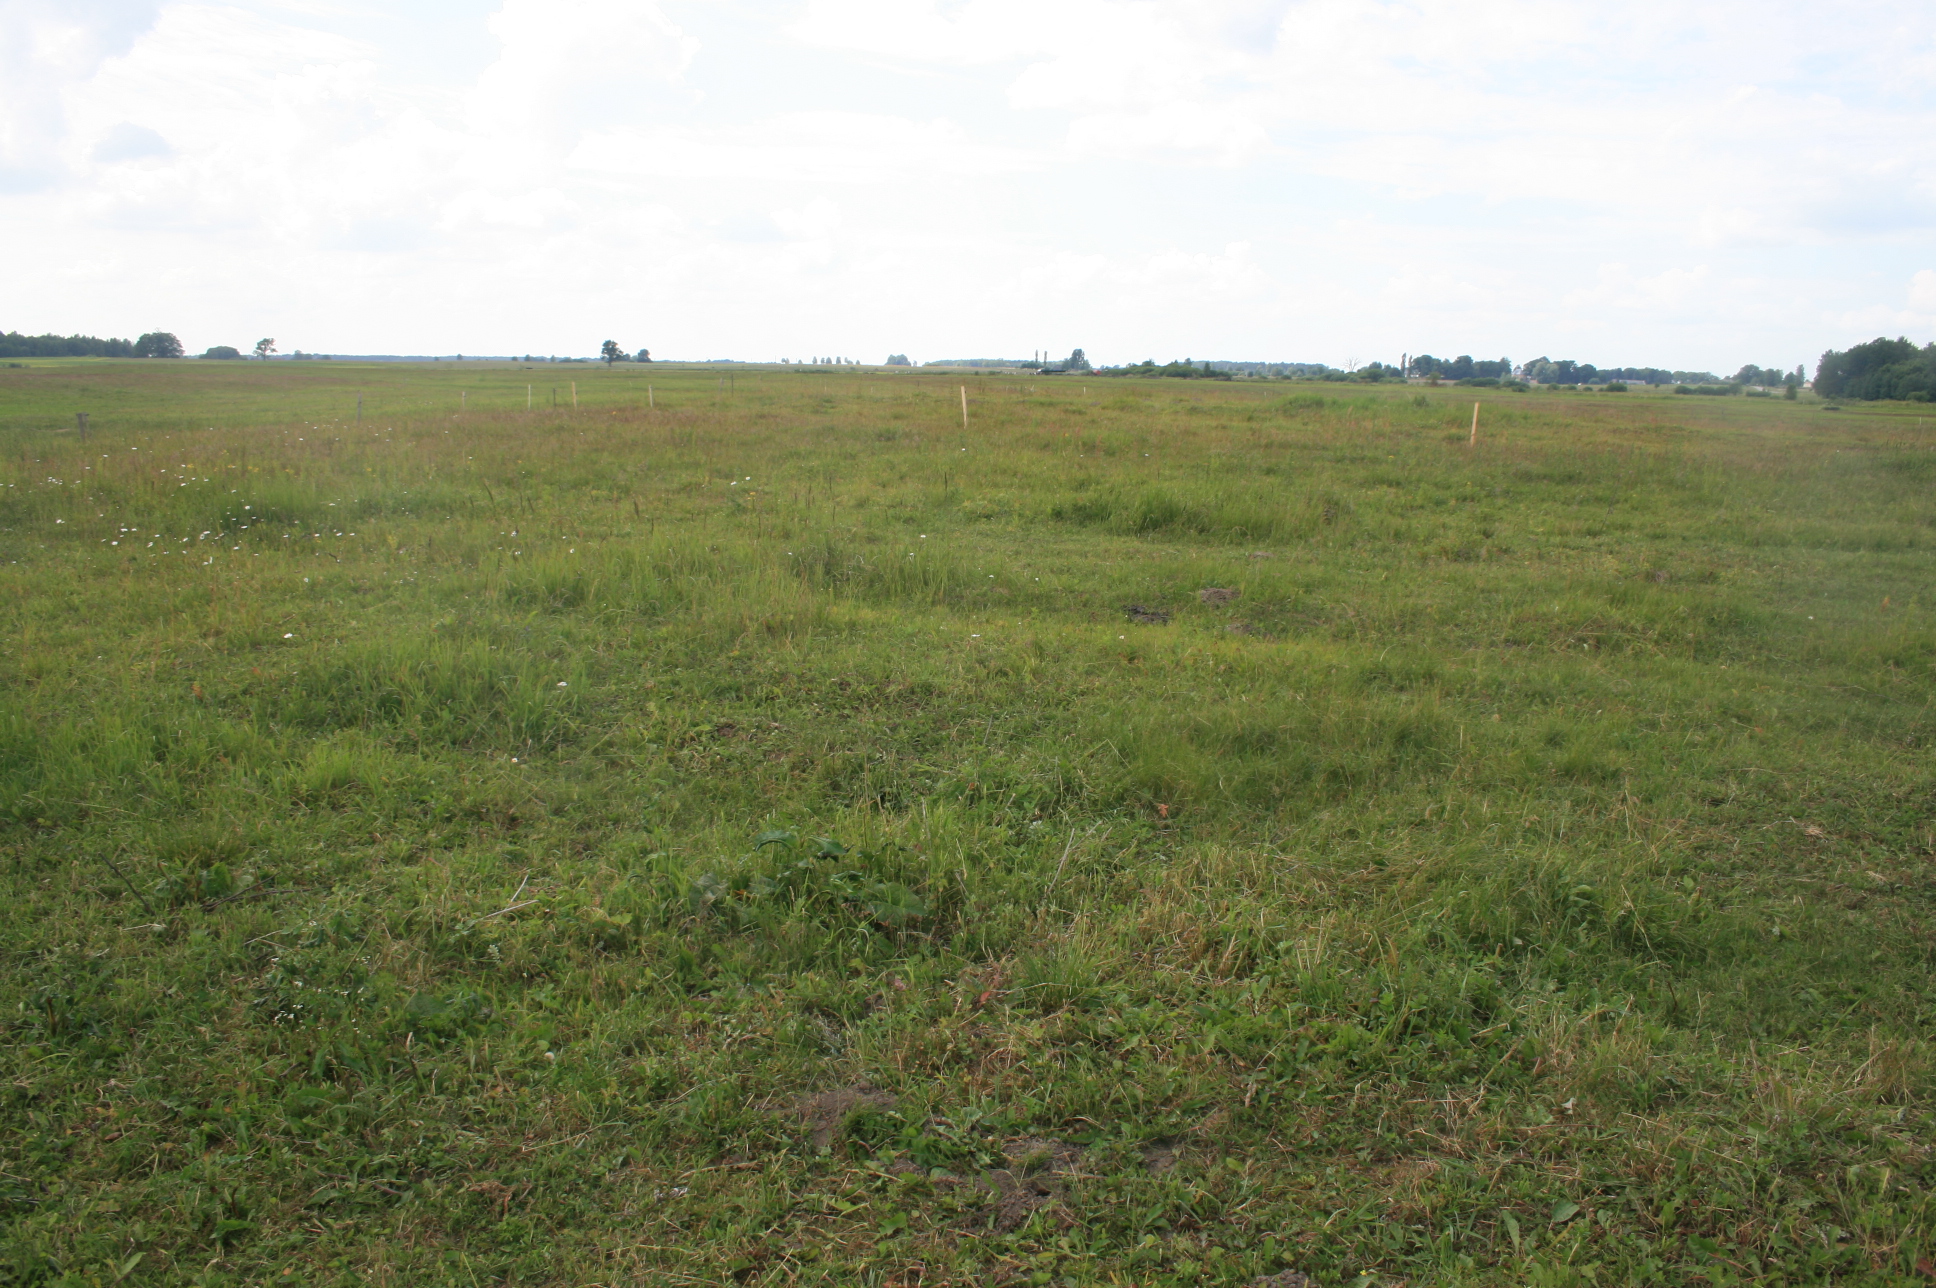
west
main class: Grassland
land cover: Grassland without tree/shrub cover
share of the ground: > 75 %
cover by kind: herbaceous plants 100 %
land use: Agriculture (excluding fallow land and kitchen gardens)
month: June
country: LT
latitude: 55.2586
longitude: 21.9962
